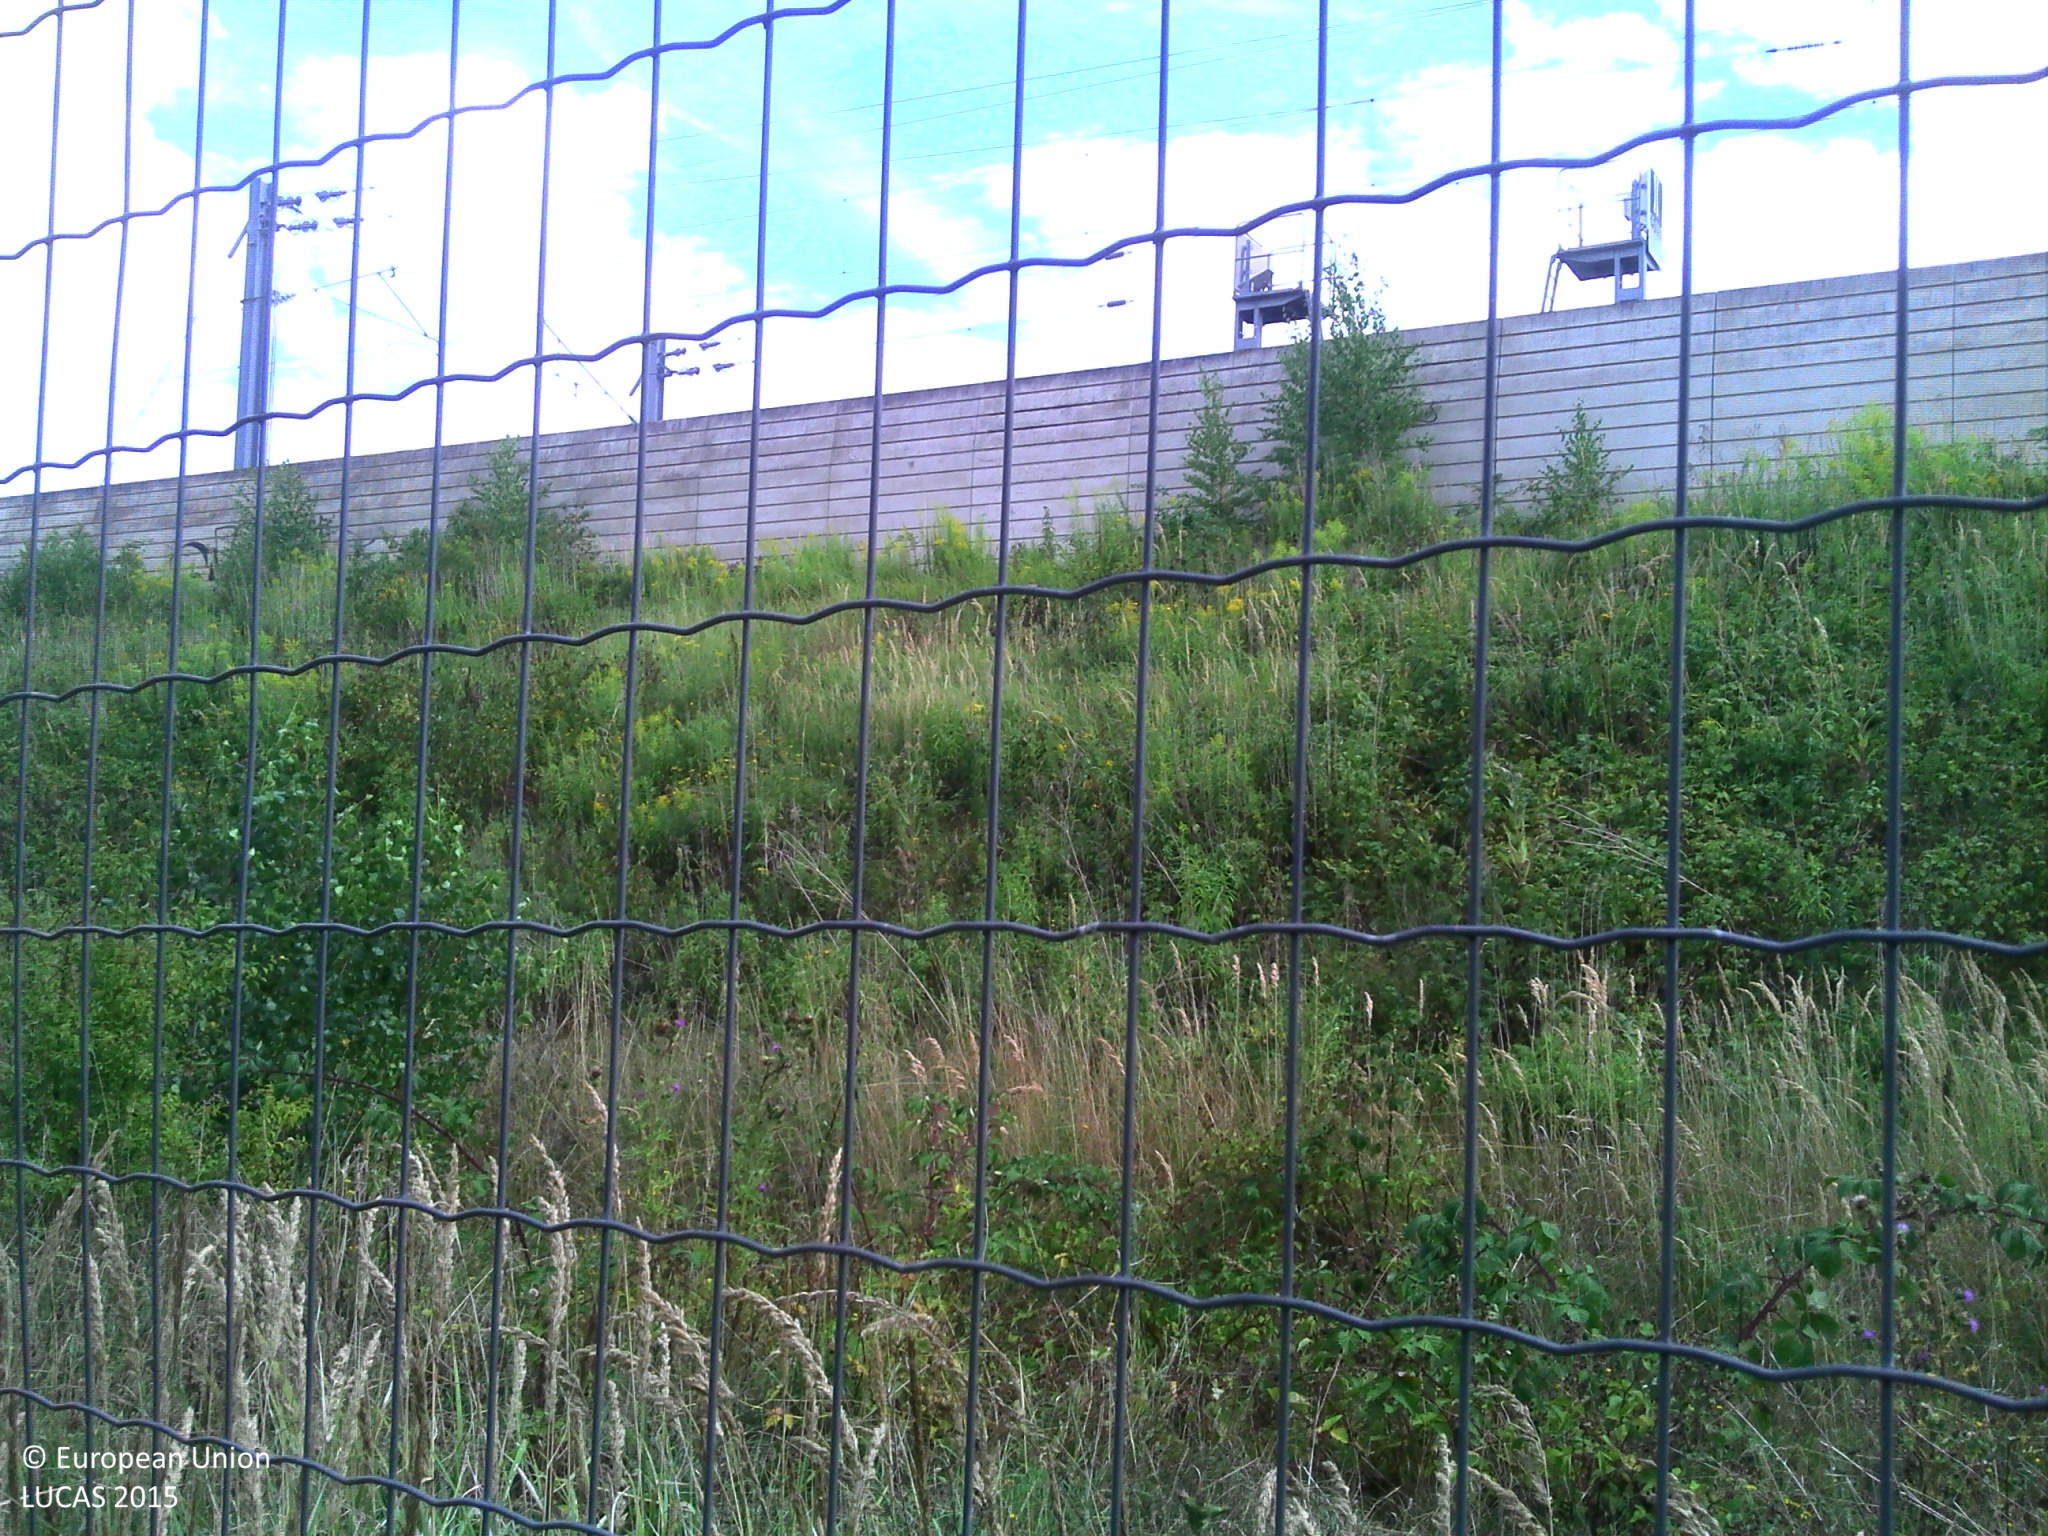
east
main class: Grassland
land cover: Spontaneously vegetated surfaces
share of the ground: > 75 %
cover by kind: herbaceous plants 85 %, lichens and mosses 5 %
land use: Semi-natural and natural areas not in use
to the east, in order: Spontaneously vegetated surfaces; Artificial constructions; Electric lines; Railways; Electric lines; Spontaneously vegetated surfaces; Fences; Electric lines; Grassland without tree/shrub cover; Fences; Paved roads, cycling and walking lanes; Fences; Grassland with sparse tree/shrub cover; Broadleaved woodland; Tracks; Broadleaved woodland
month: August
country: FR
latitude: 48.8824
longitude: 2.6667
